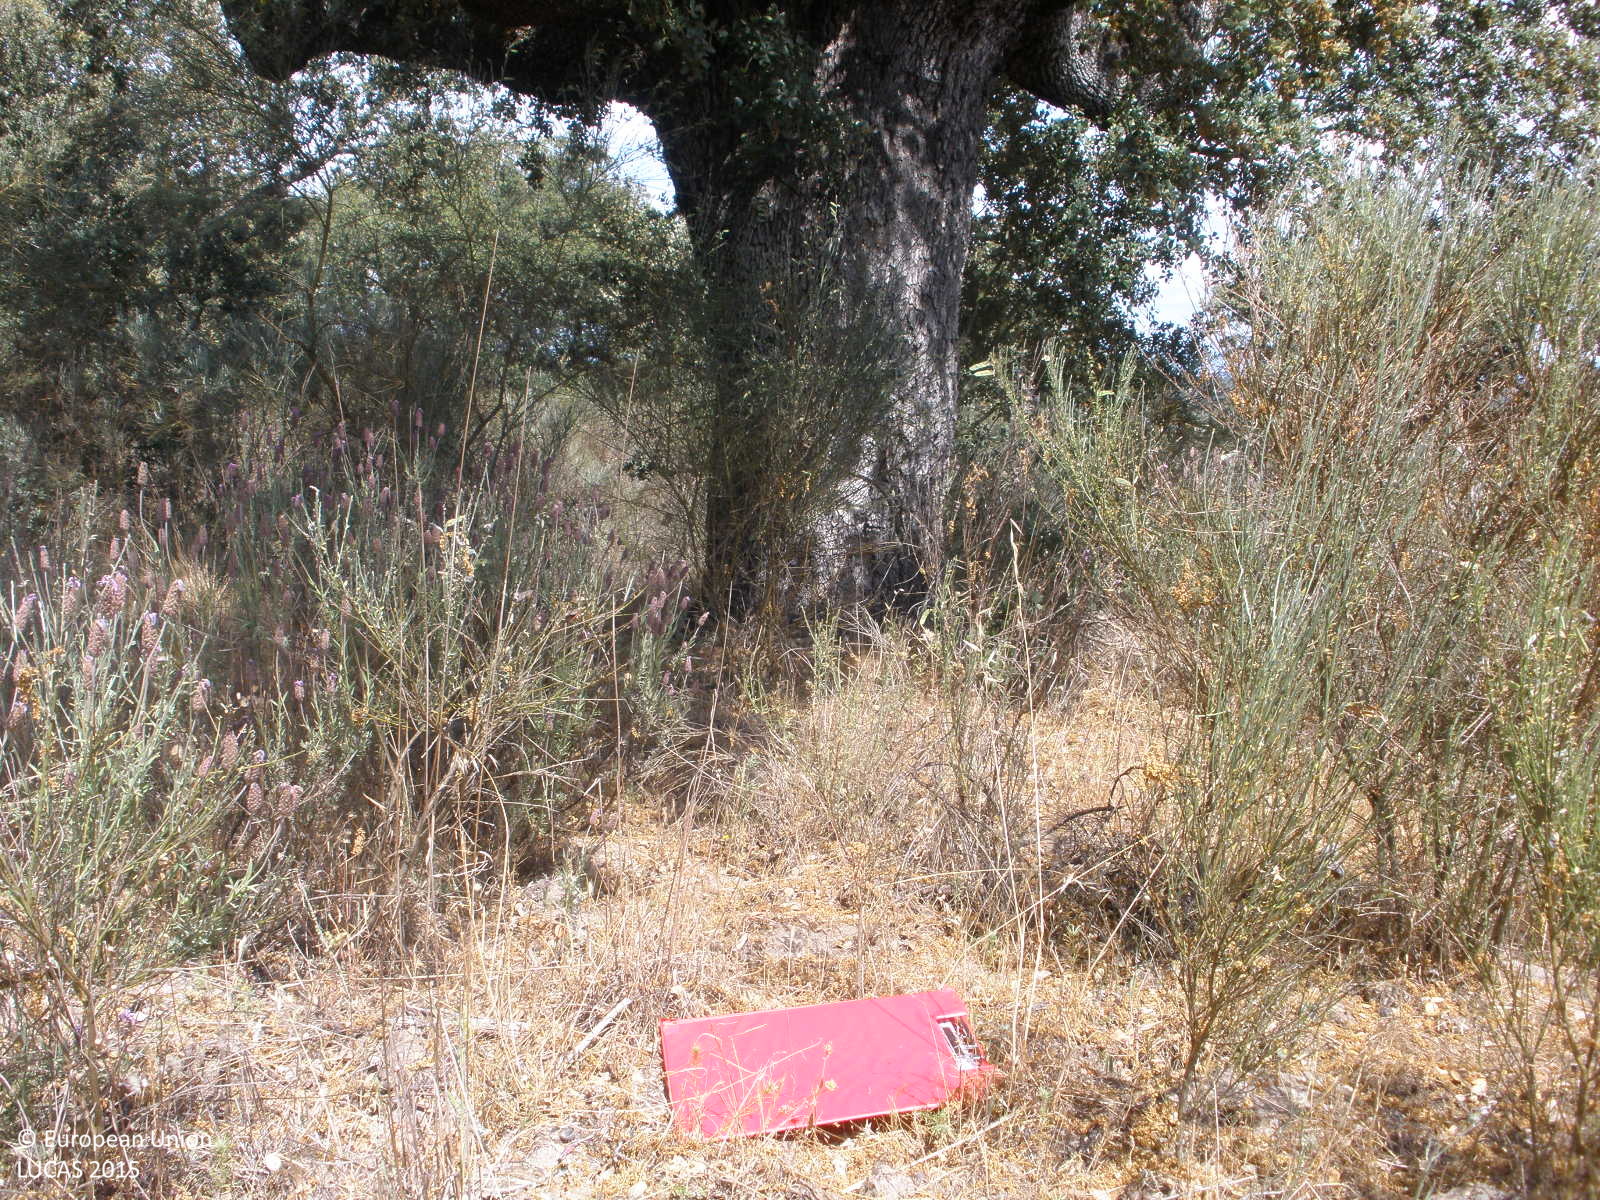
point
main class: Woodland
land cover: Broadleaved woodland
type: broadleaved evergreen forest
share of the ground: > 75 %
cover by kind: shrubs 50 %, broadleaved forest trees 40 %, herbaceous plants 10 %
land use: Semi-natural and natural areas not in use
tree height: > 5 m
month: June
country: ES
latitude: 40.5941
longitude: -6.6952
